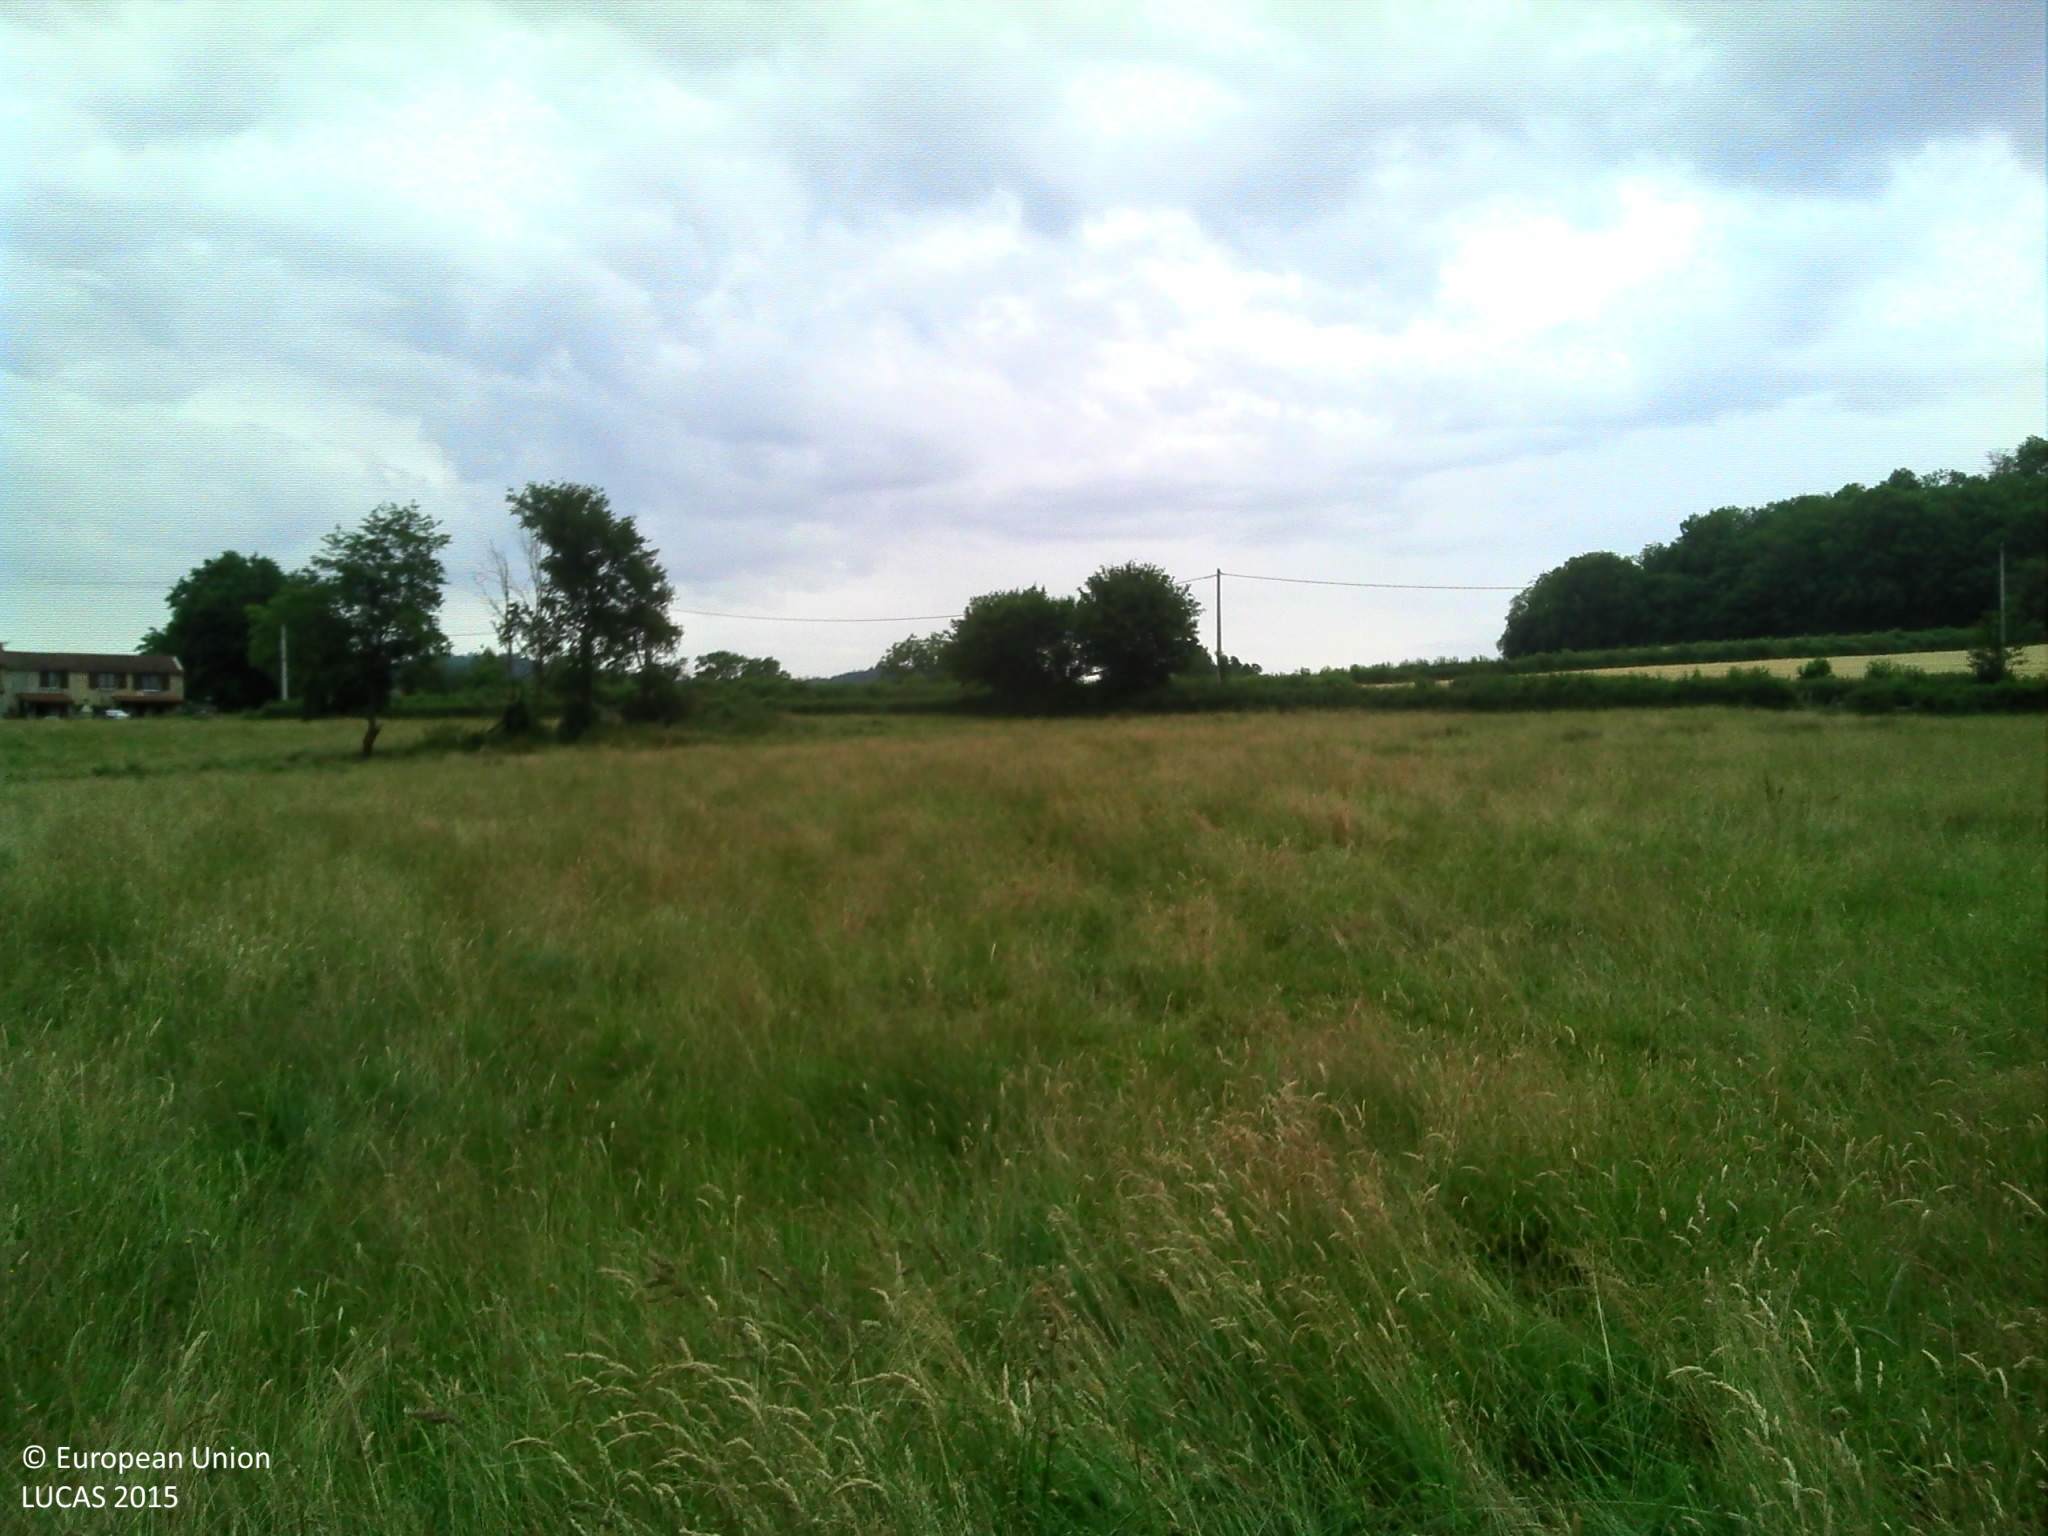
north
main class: Grassland
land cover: Grassland without tree/shrub cover
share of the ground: > 75 %
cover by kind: herbaceous plants 100 %
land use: Agriculture (excluding fallow land and kitchen gardens)
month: June
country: FR
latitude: 46.3570
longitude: 4.5563
